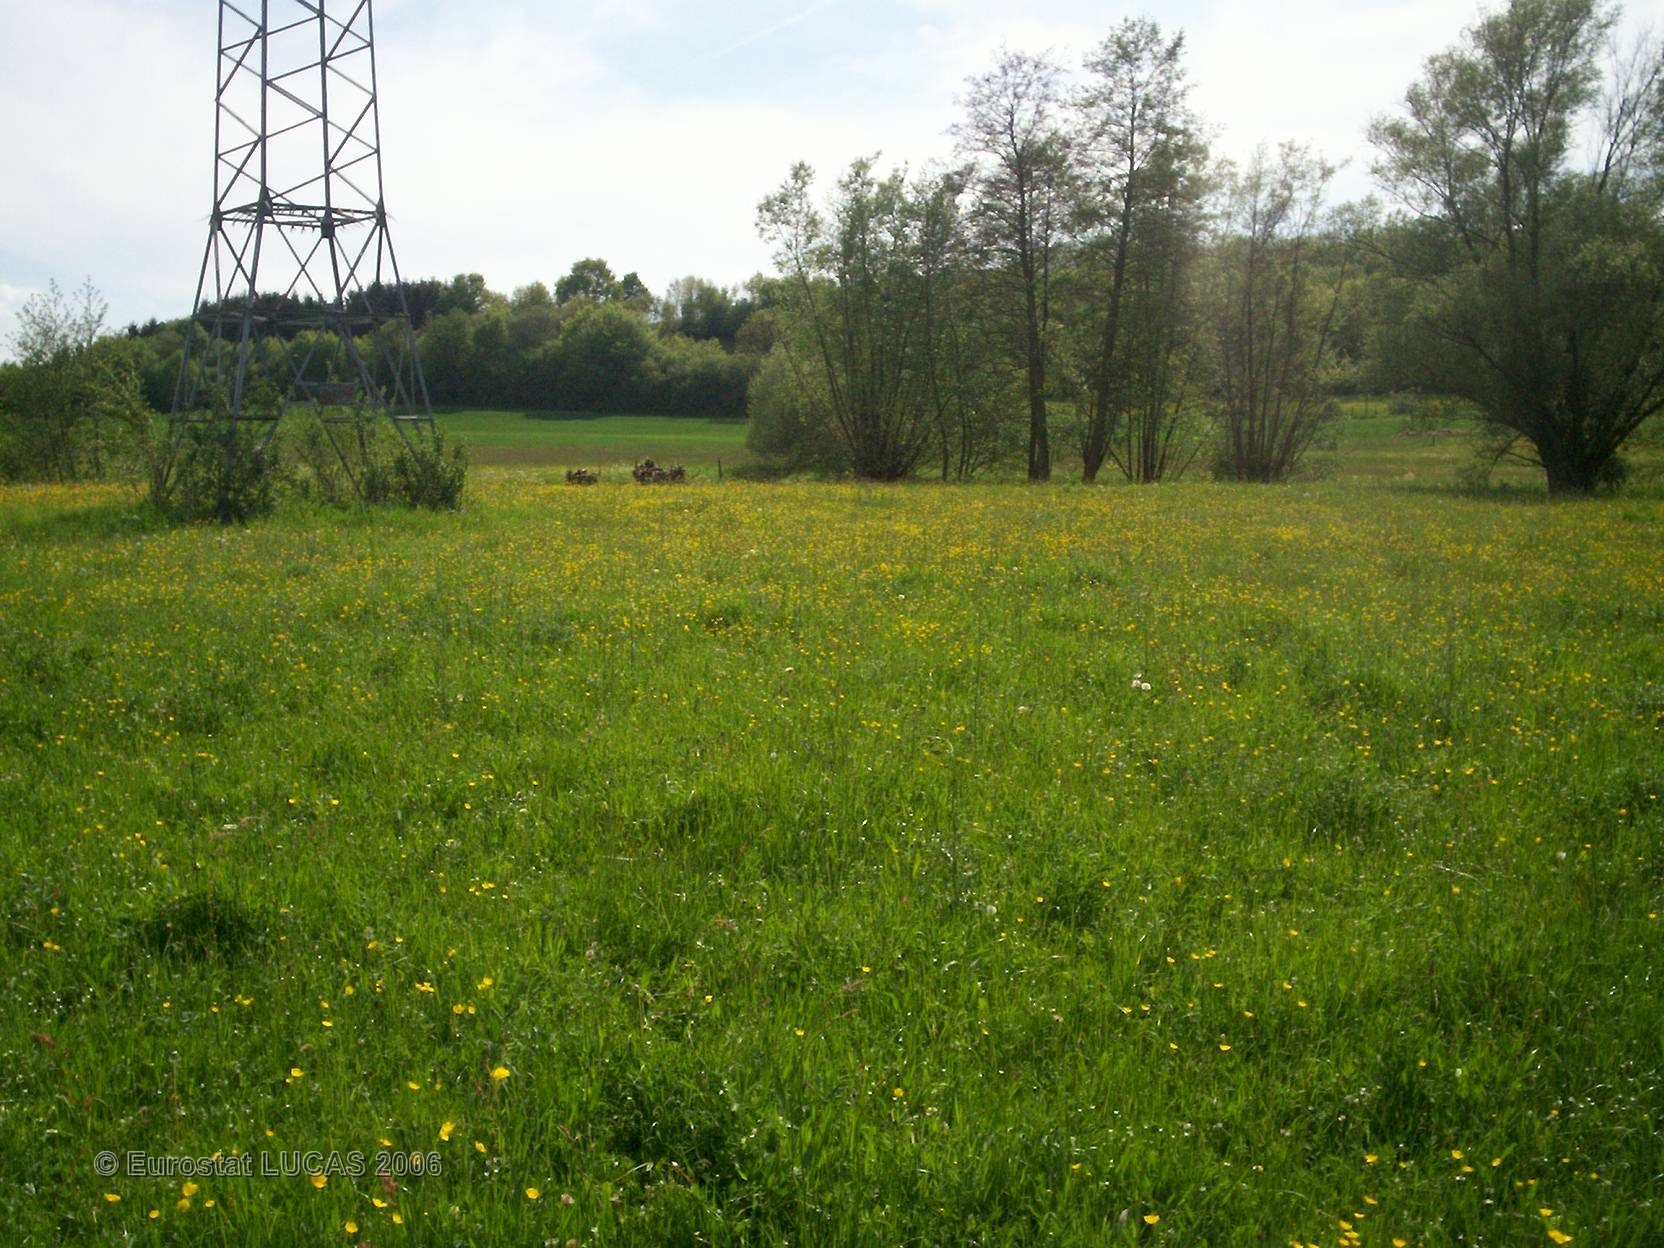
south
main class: Grassland
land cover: Grassland without tree/shrub cover
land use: Agriculture (excluding fallow land and kitchen gardens)
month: May
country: FR
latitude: 48.8328
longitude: 7.0716
